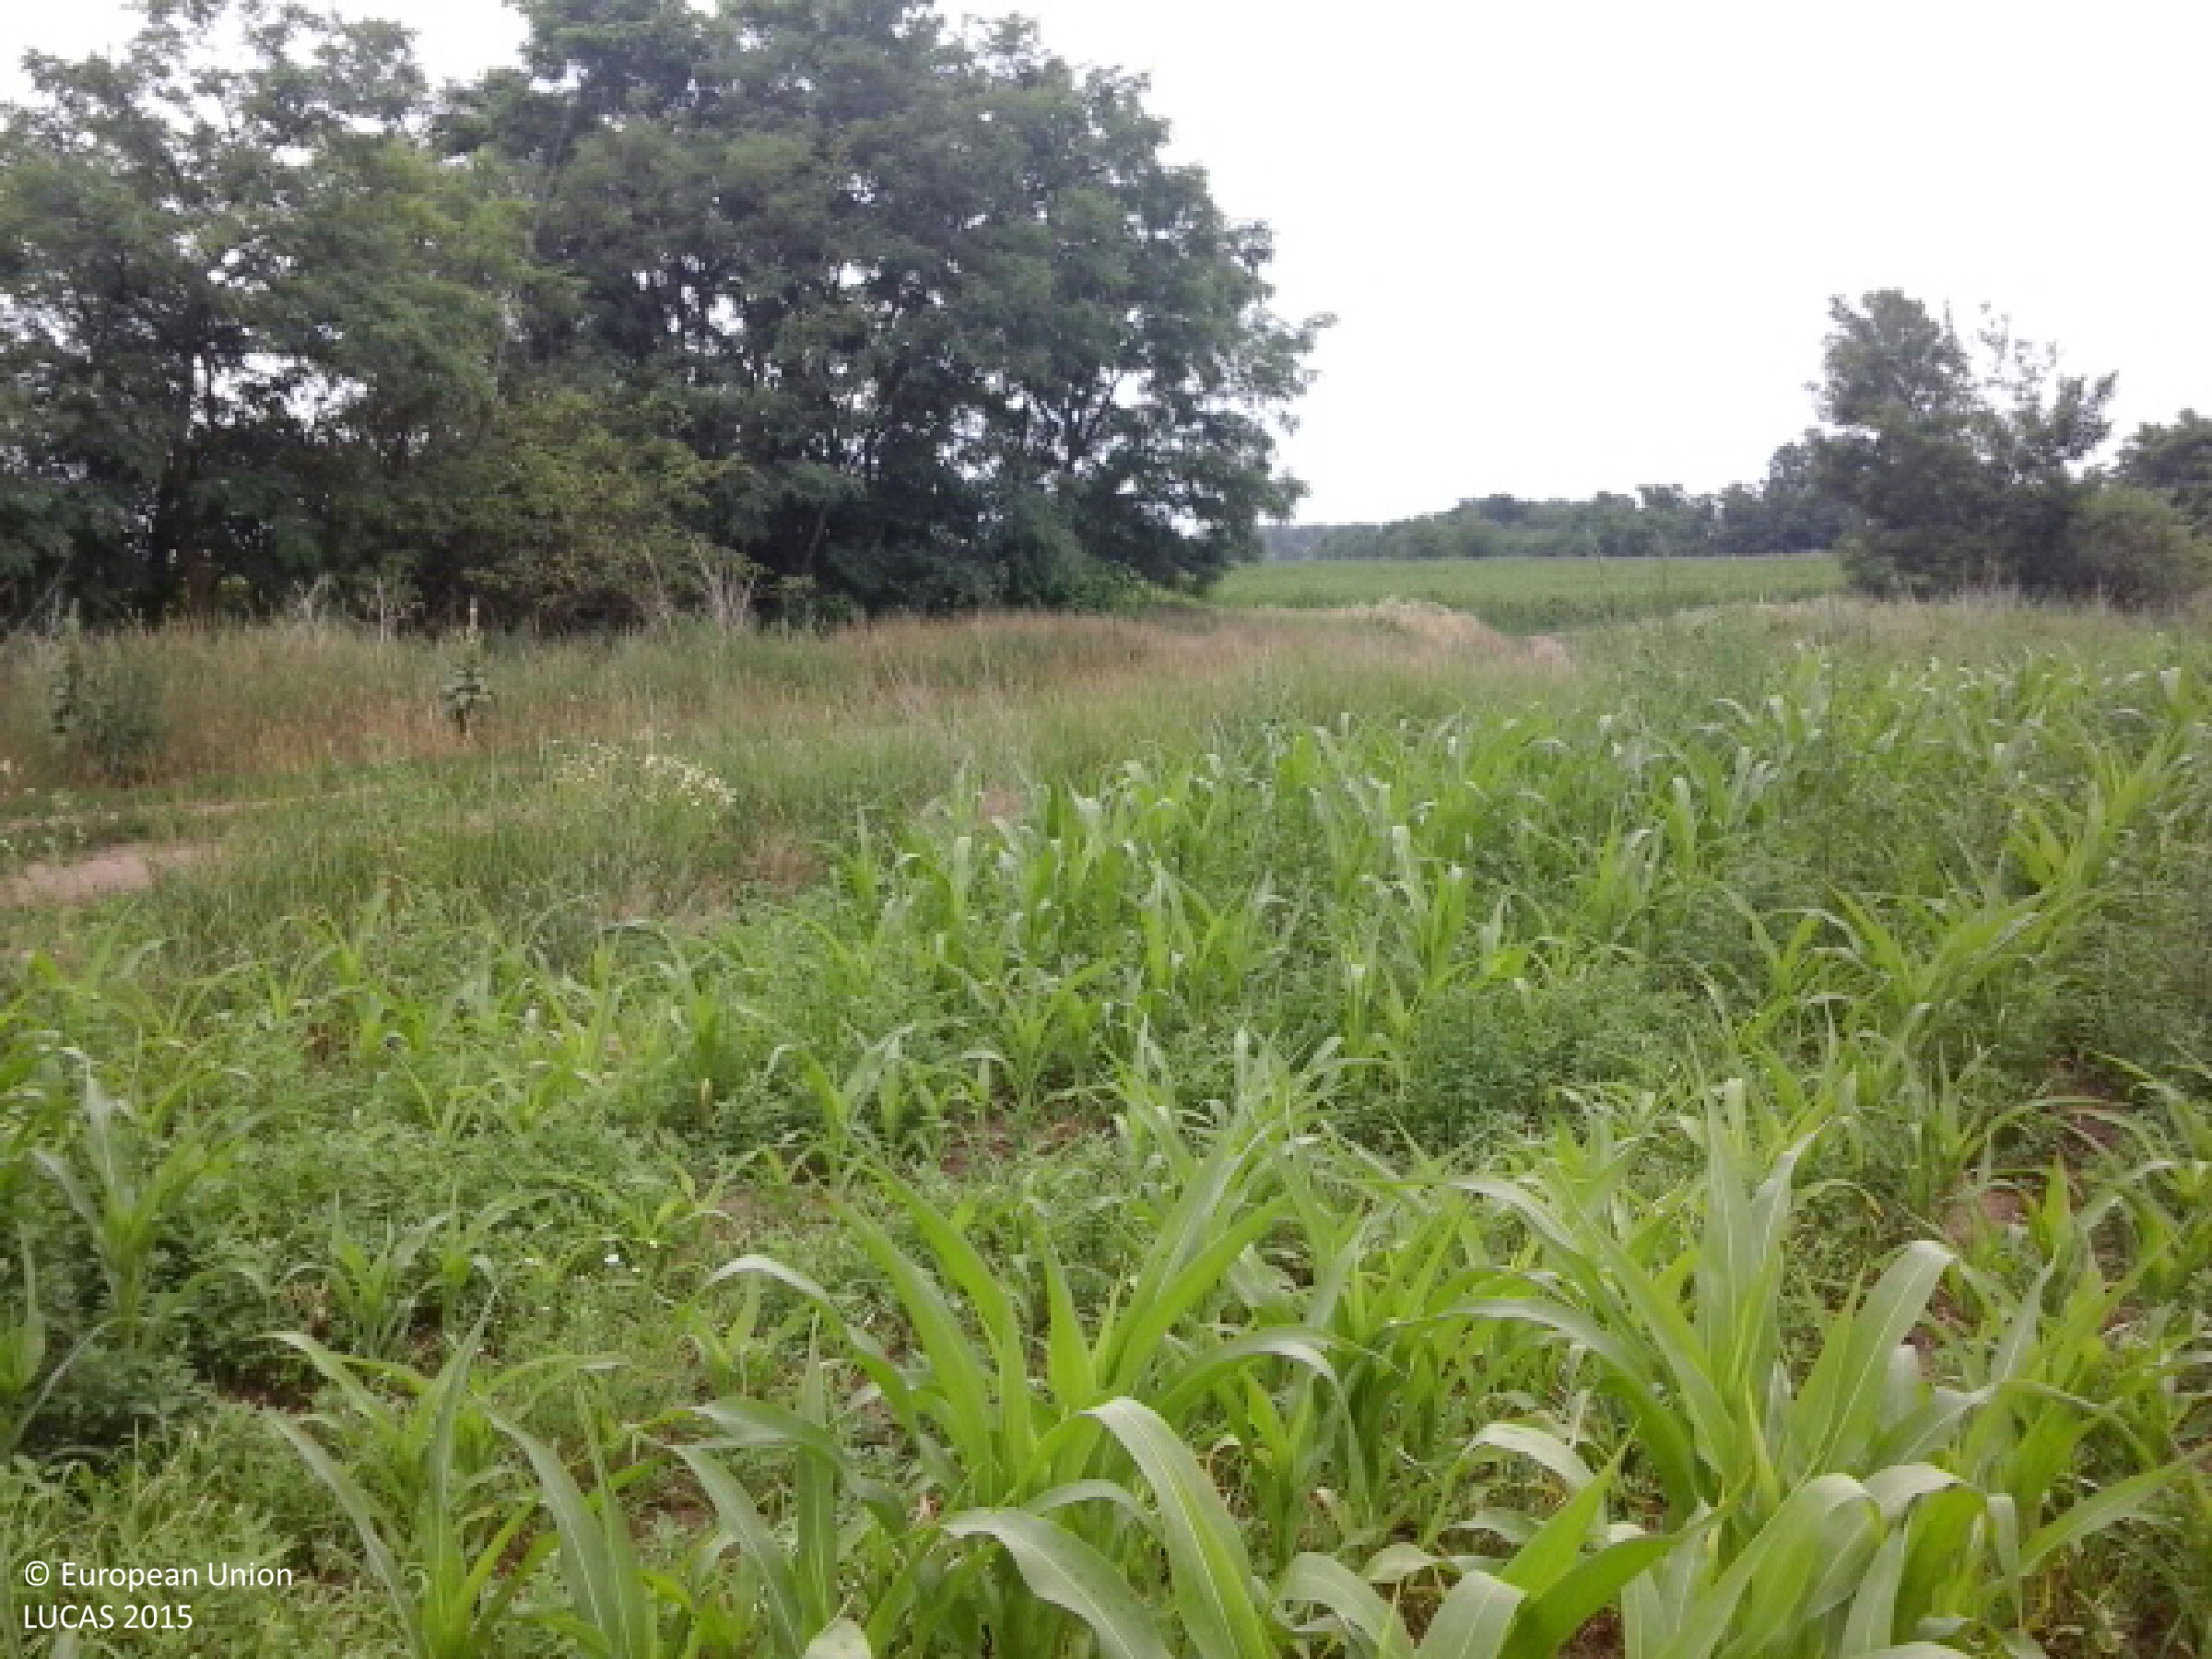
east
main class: Cropland
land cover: Maize
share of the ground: > 75 %
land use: Agriculture (excluding fallow land and kitchen gardens)
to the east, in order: Maize; Grass margins; Tracks; Grass margins; Sunflower; Tracks; Lines of trees; Grassland without tree/shrub cover
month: June
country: HU
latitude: 48.1249
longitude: 21.5330
